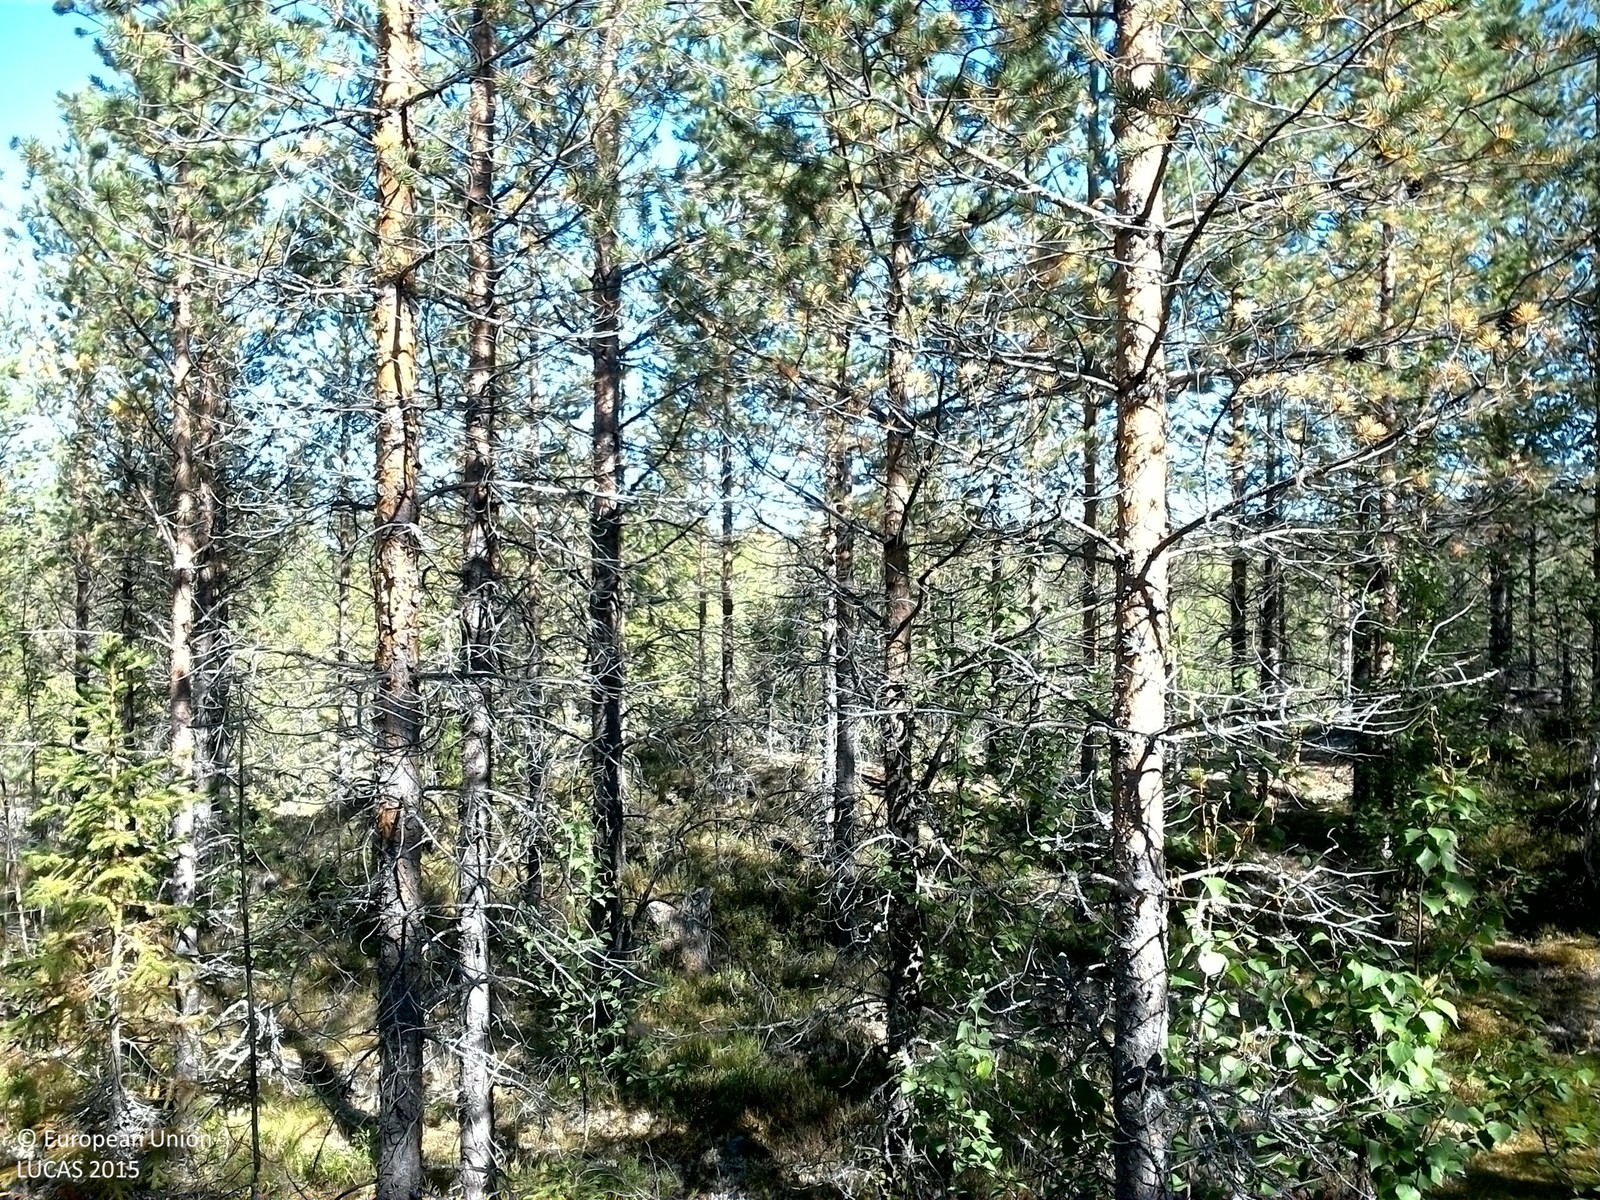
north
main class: Woodland
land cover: Pine dominated coniferous woodland
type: boreal forest
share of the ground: > 75 %
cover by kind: coniferous forest trees 75 %, shrubs 15 %, herbaceous plants 5 %, lichens and mosses 5 %
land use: Forestry
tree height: < 5 m
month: August
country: SE
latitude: 63.7249
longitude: 17.2411
